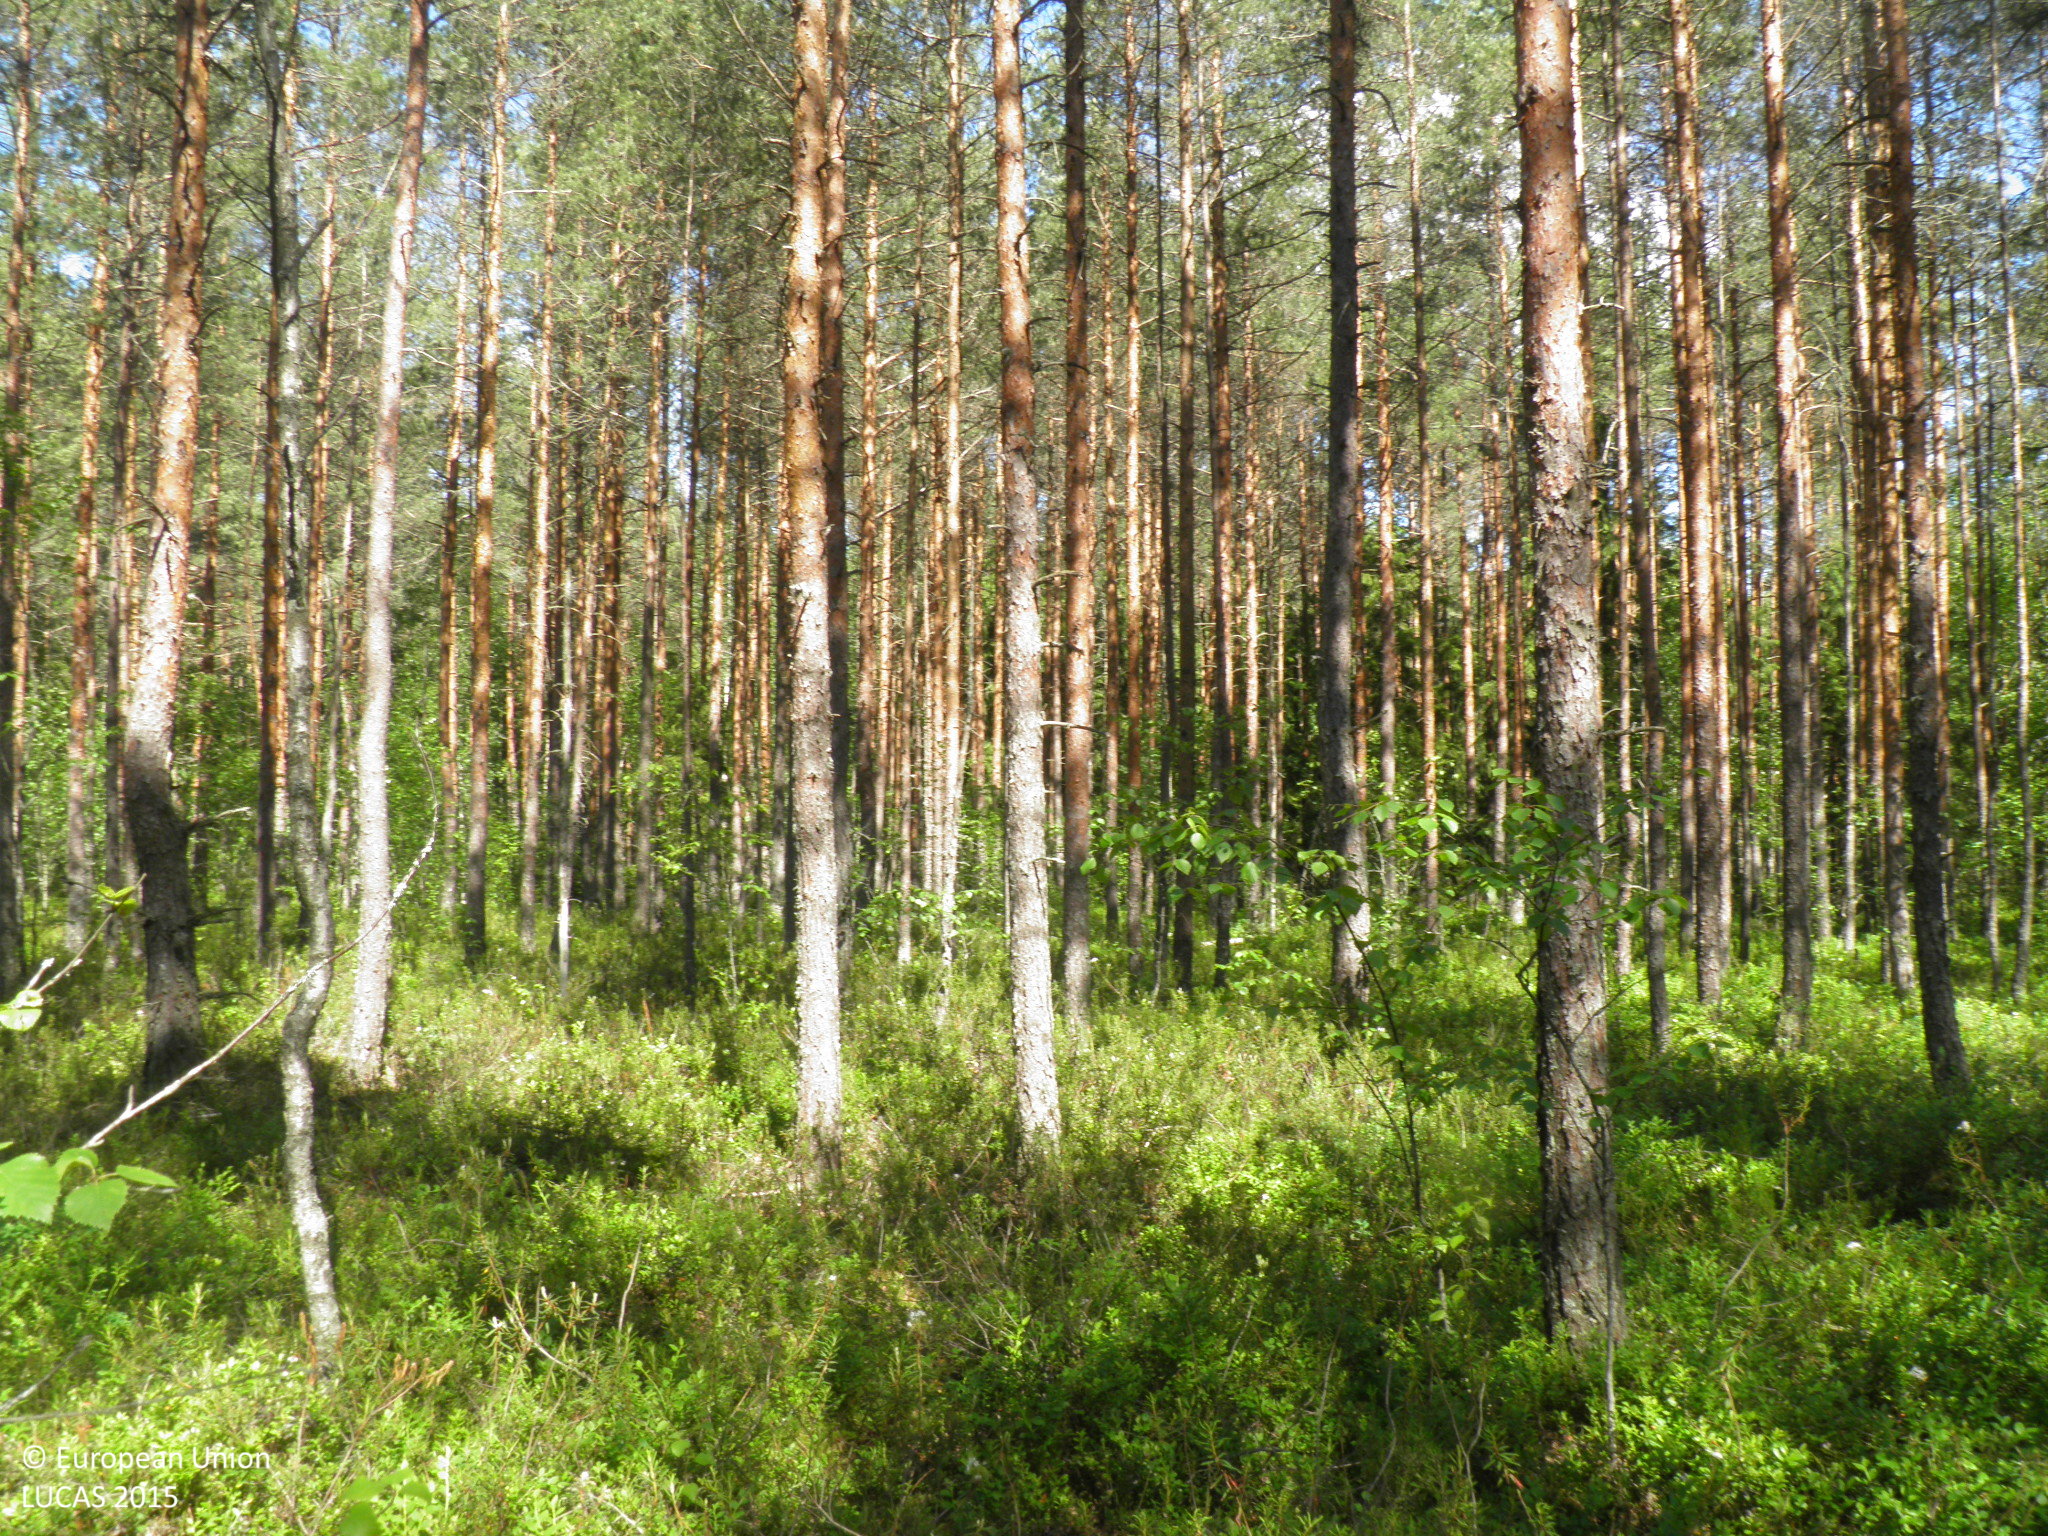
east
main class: Woodland
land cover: Pine dominated coniferous woodland
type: hemiboreal forest and nemoral coniferous forest and mixed broadleaved-coniferous forest
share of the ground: > 75 %
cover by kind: coniferous forest trees 75 %, shrubs 15 %, lichens and mosses 10 %
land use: Forestry
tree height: > 5 m
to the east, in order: Pine dominated coniferous woodland; Ditches and canals; Spruce dominated mixed woodland; Ditches and canals; Spruce dominated coniferous woodland; Pine dominated coniferous woodland
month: June
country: FI
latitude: 60.4726
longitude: 22.7898
